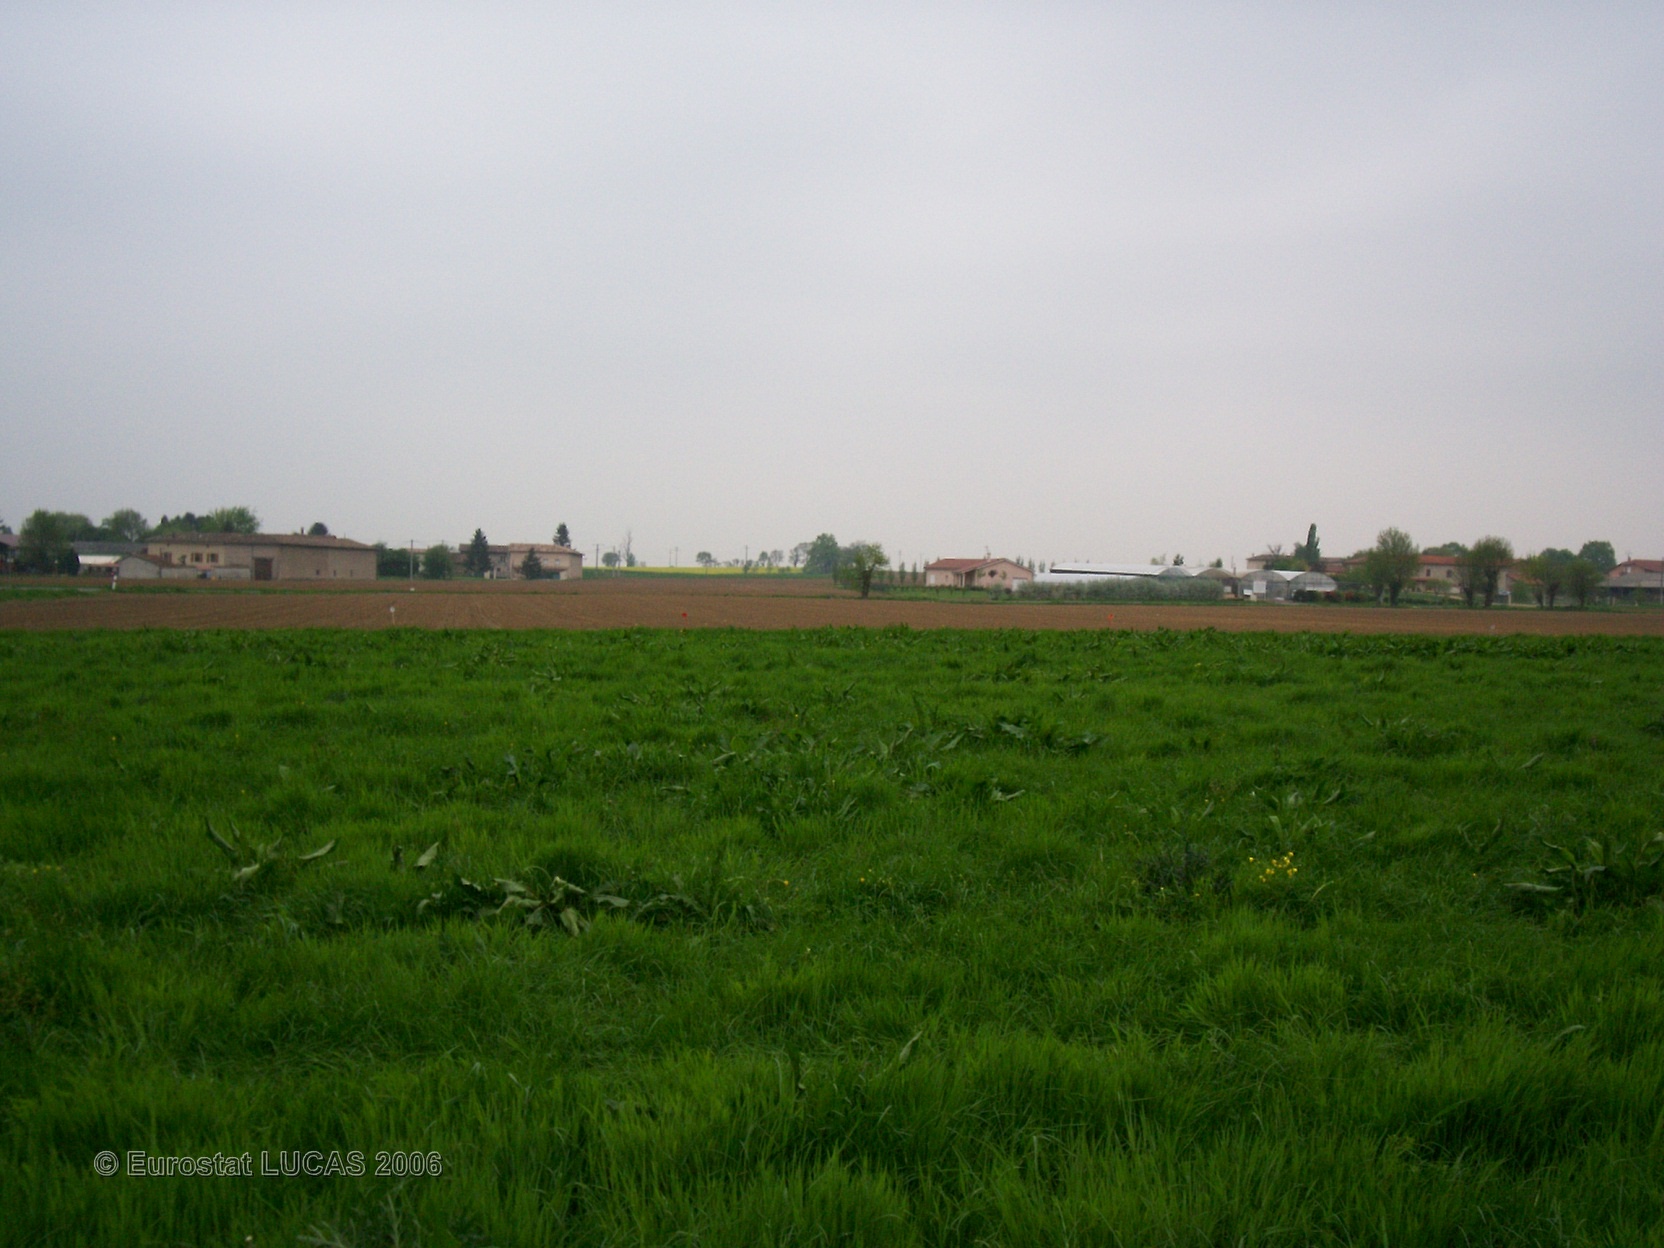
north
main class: Grassland
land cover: Grassland without tree/shrub cover
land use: Agriculture (excluding fallow land and kitchen gardens)
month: April
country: FR
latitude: 46.0261
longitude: 4.7967
